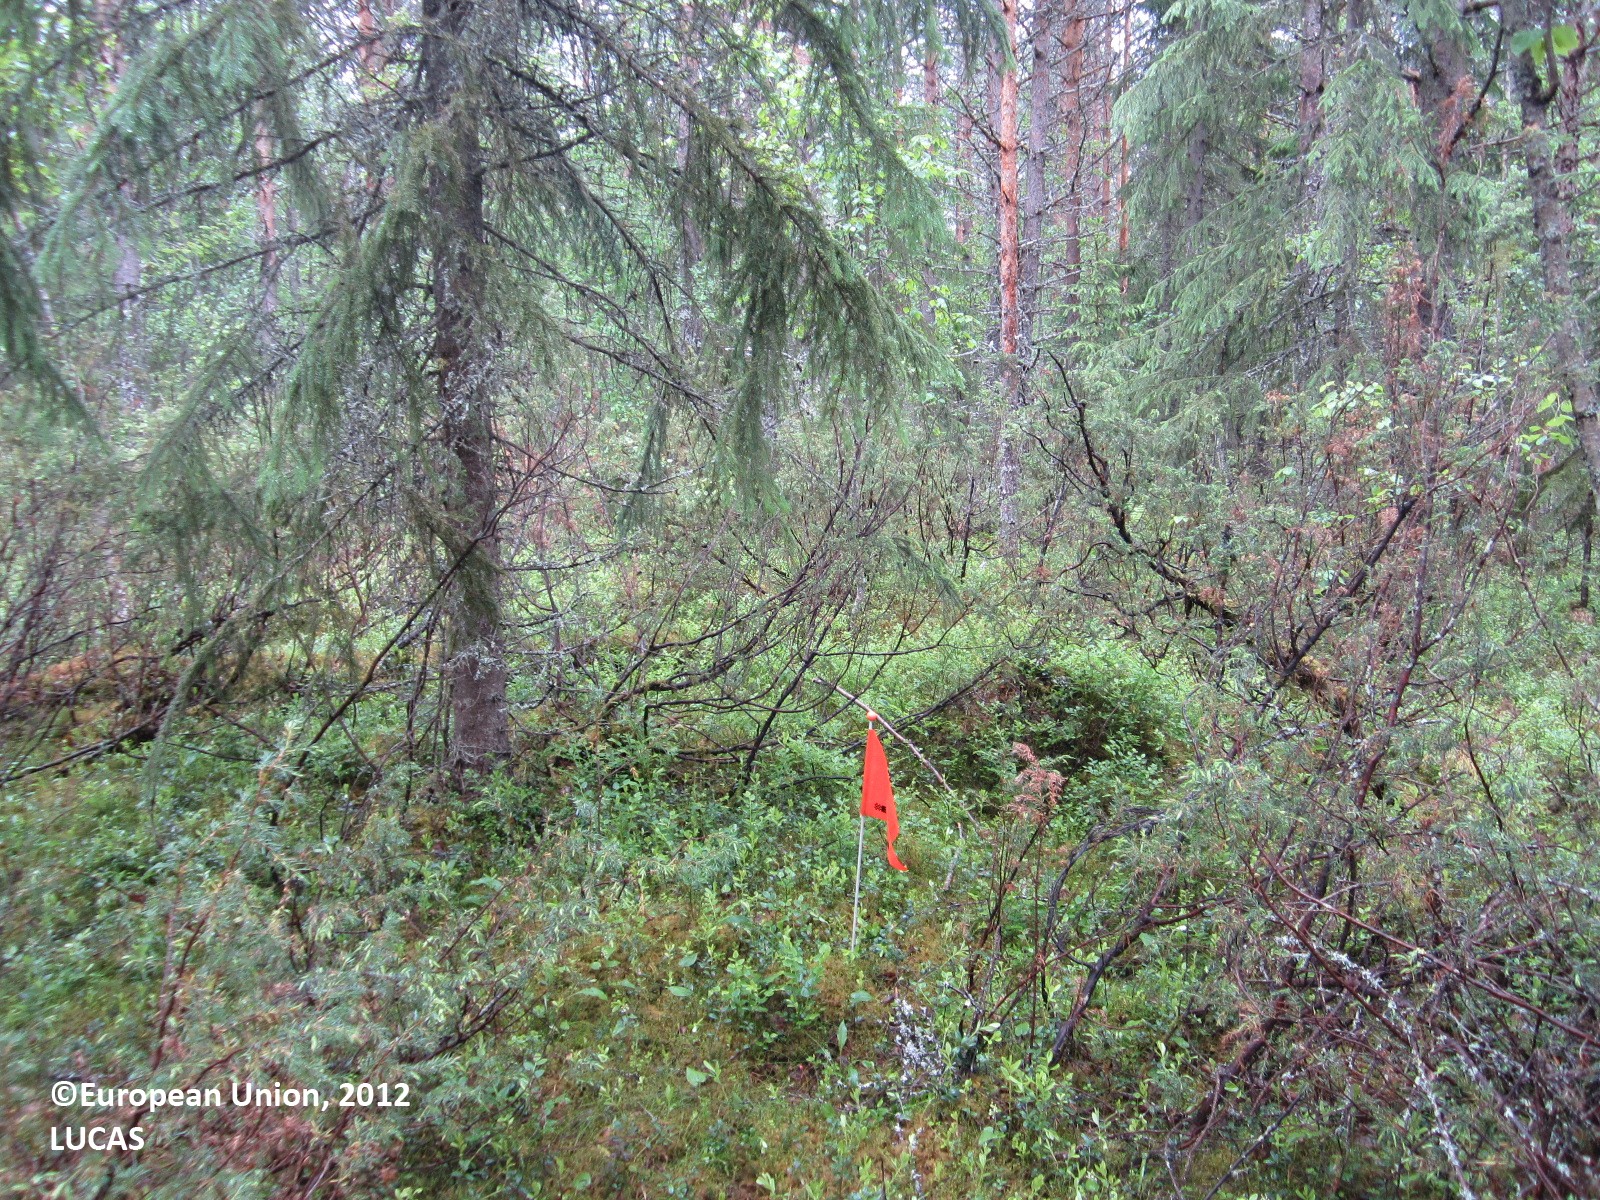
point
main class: Woodland
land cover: Pine dominated mixed woodland
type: boreal forest
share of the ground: > 75 %
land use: Forestry
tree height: > 5 m
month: June
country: FI
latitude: 64.5089
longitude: 29.8664
